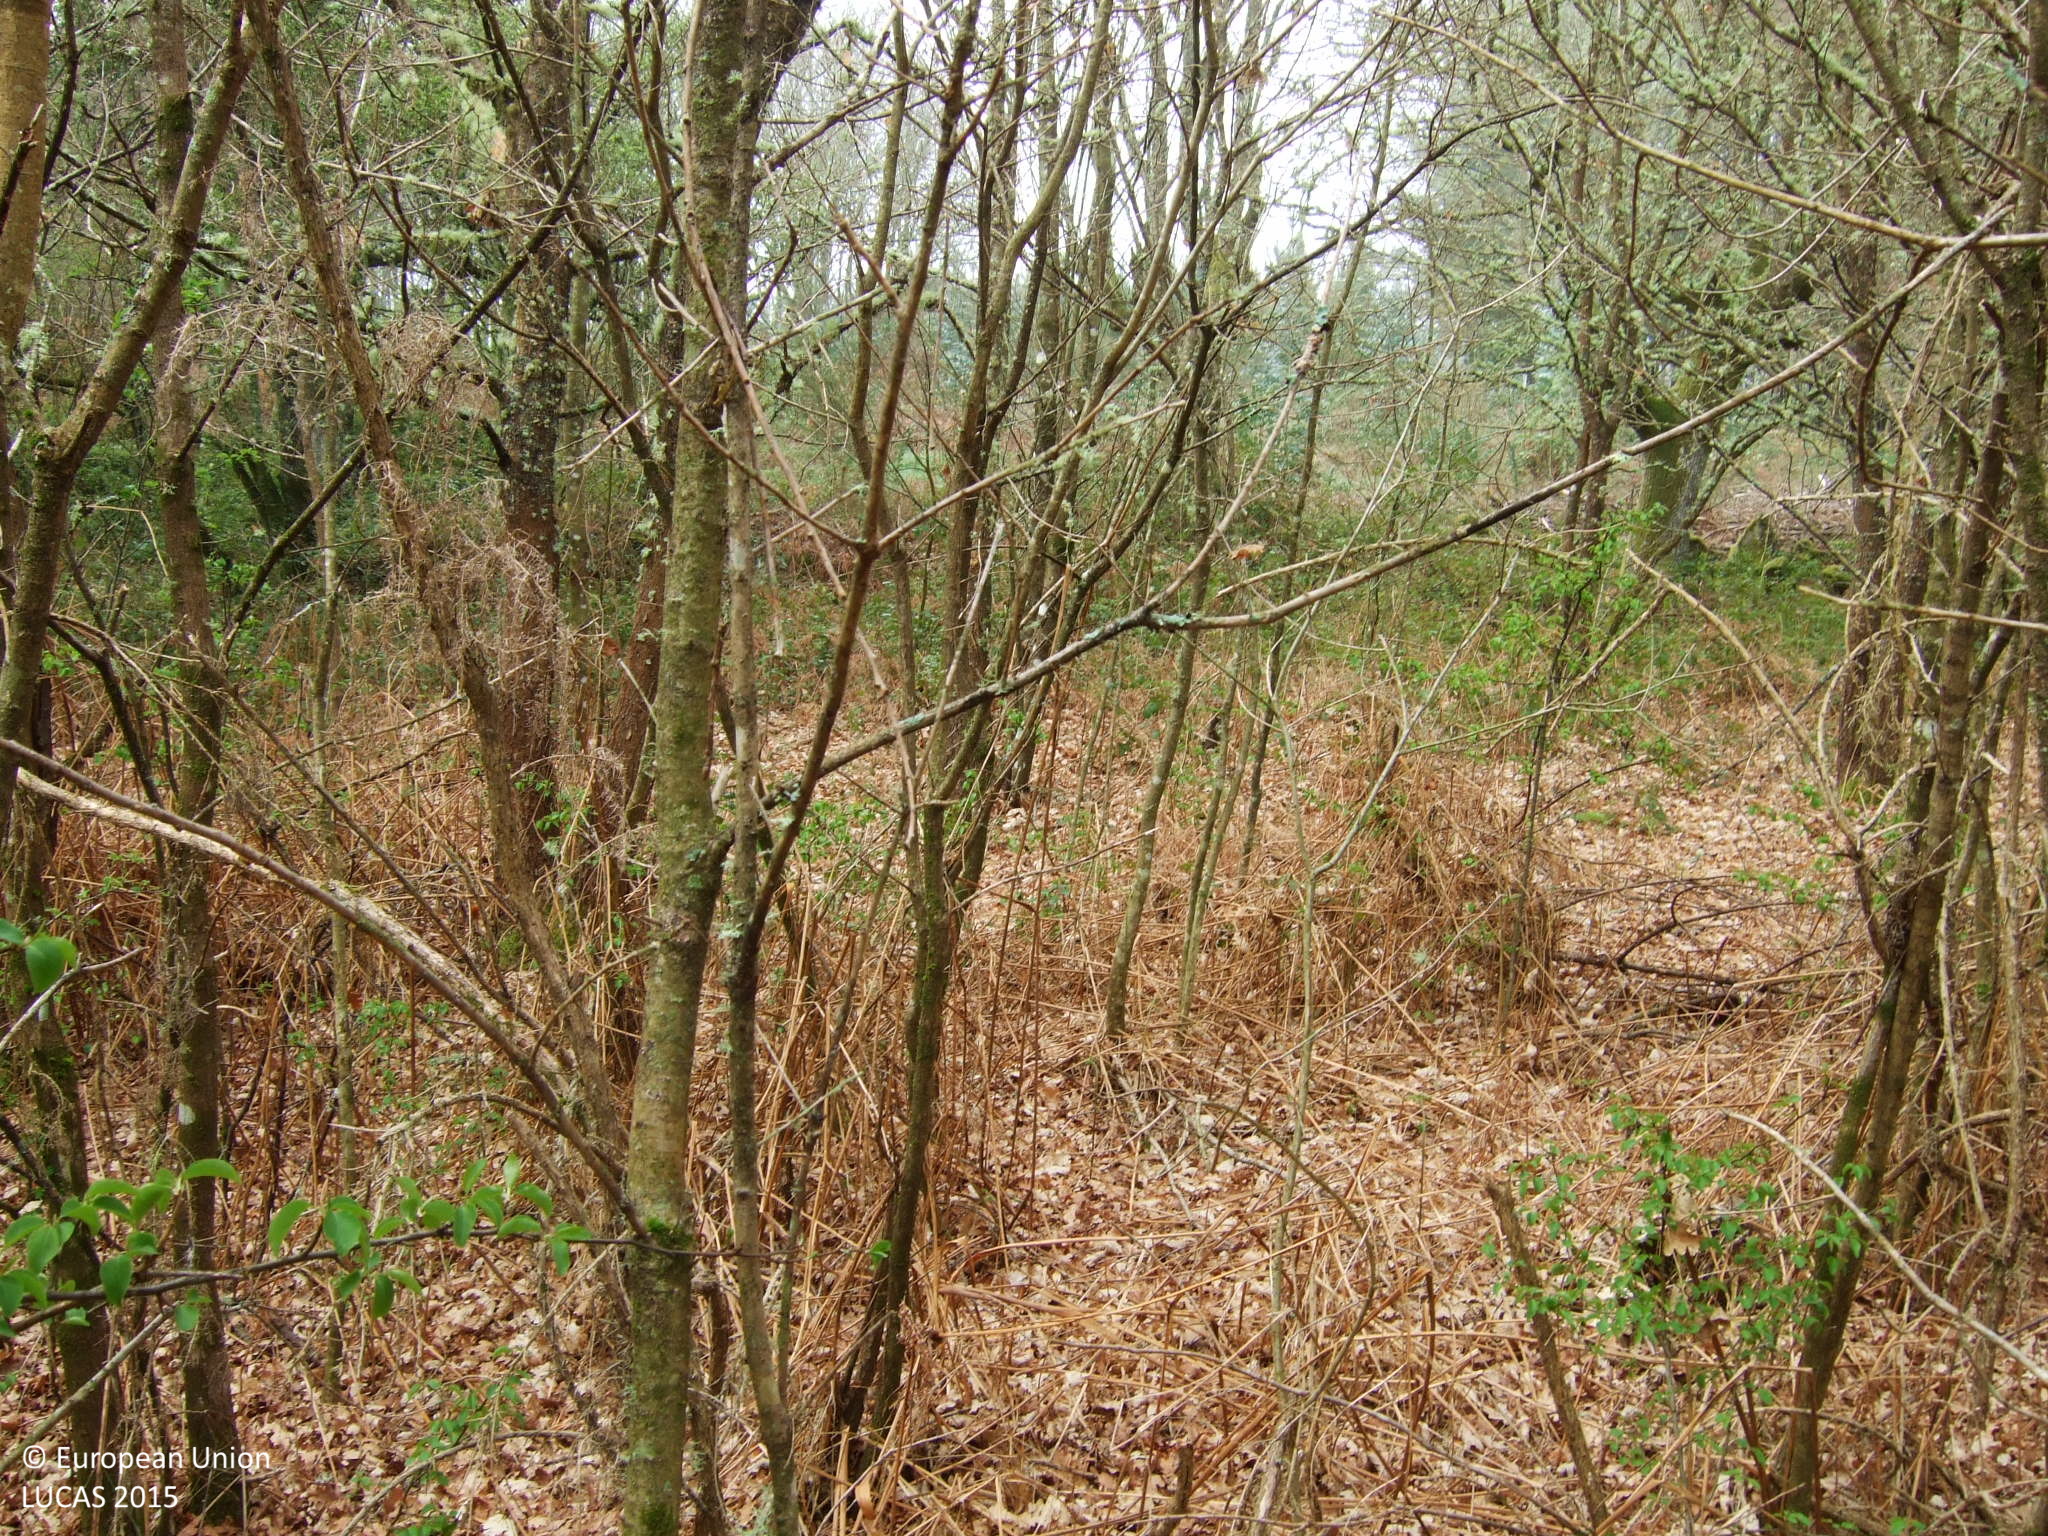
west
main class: Woodland
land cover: Broadleaved woodland
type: acidophilous oak and oak-birch forest
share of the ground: 50 - 75 %
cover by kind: broadleaved forest trees 70 %, shrubs 30 %
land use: Semi-natural and natural areas not in use
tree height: > 5 m
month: April
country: ES
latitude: 42.7750
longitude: -7.8160
